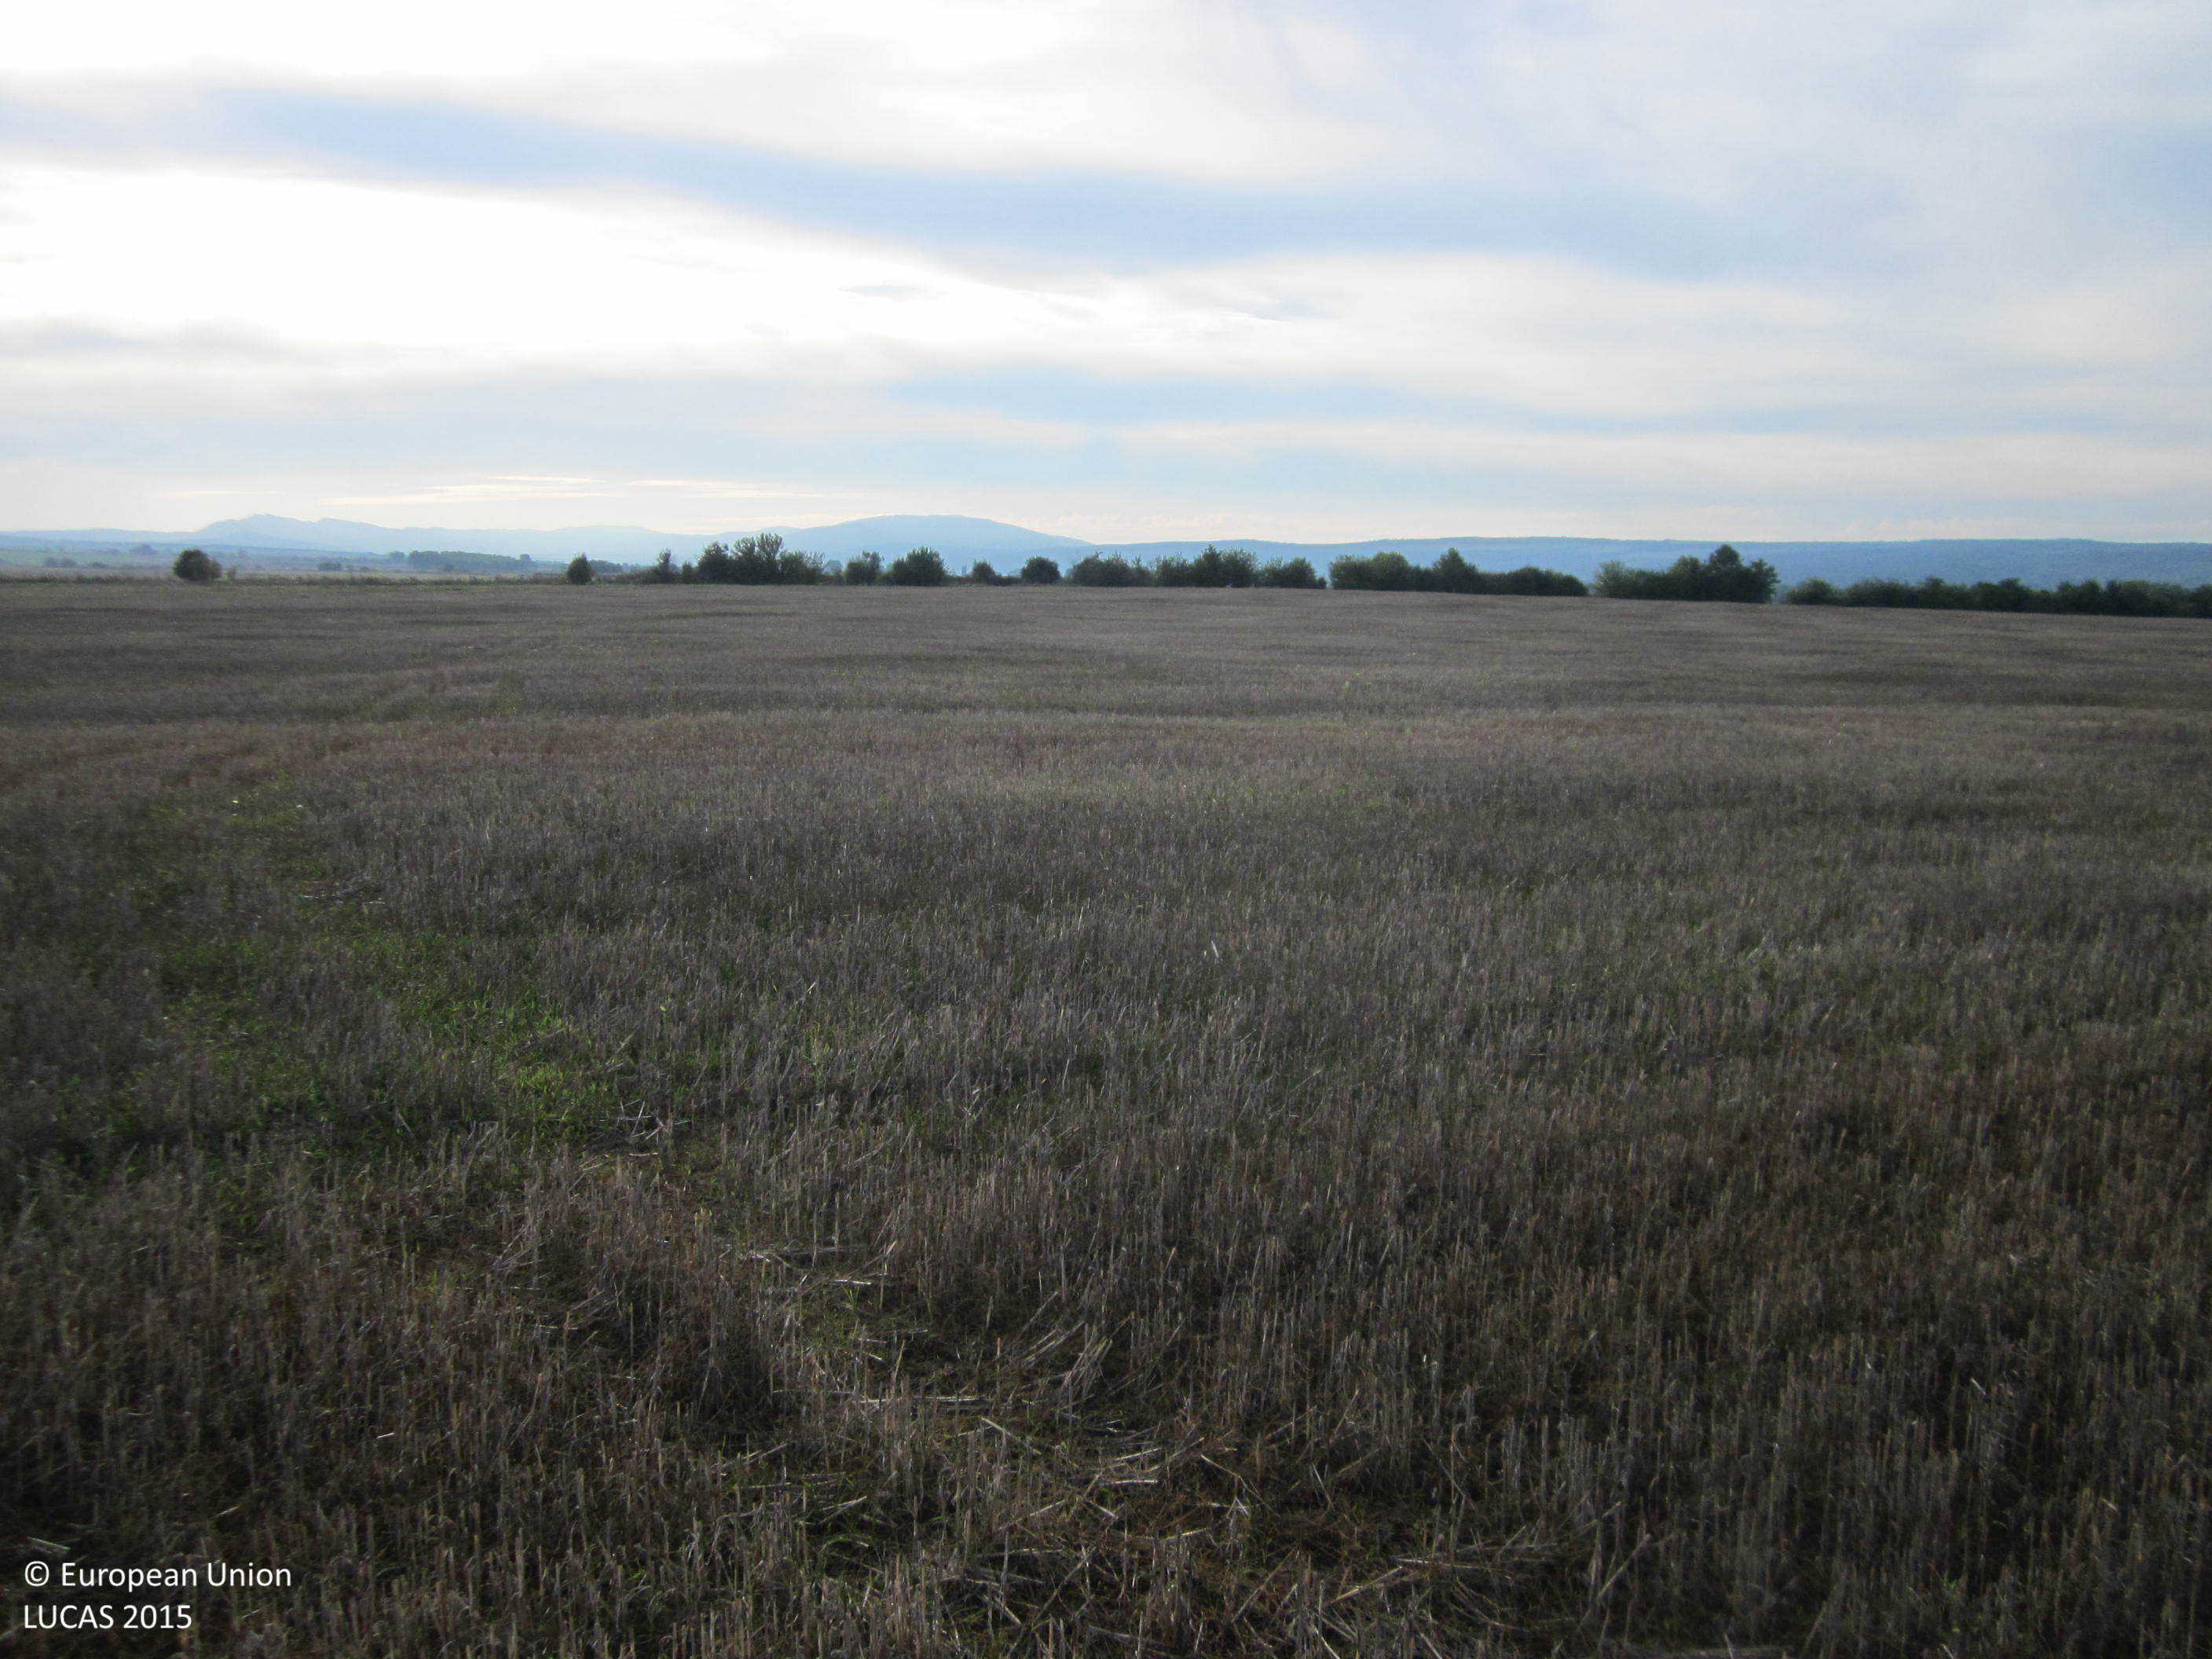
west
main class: Cropland
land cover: Common wheat
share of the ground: 50 - 75 %
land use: Agriculture (excluding fallow land and kitchen gardens)
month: October
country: BG
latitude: 42.7475
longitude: 26.8033
